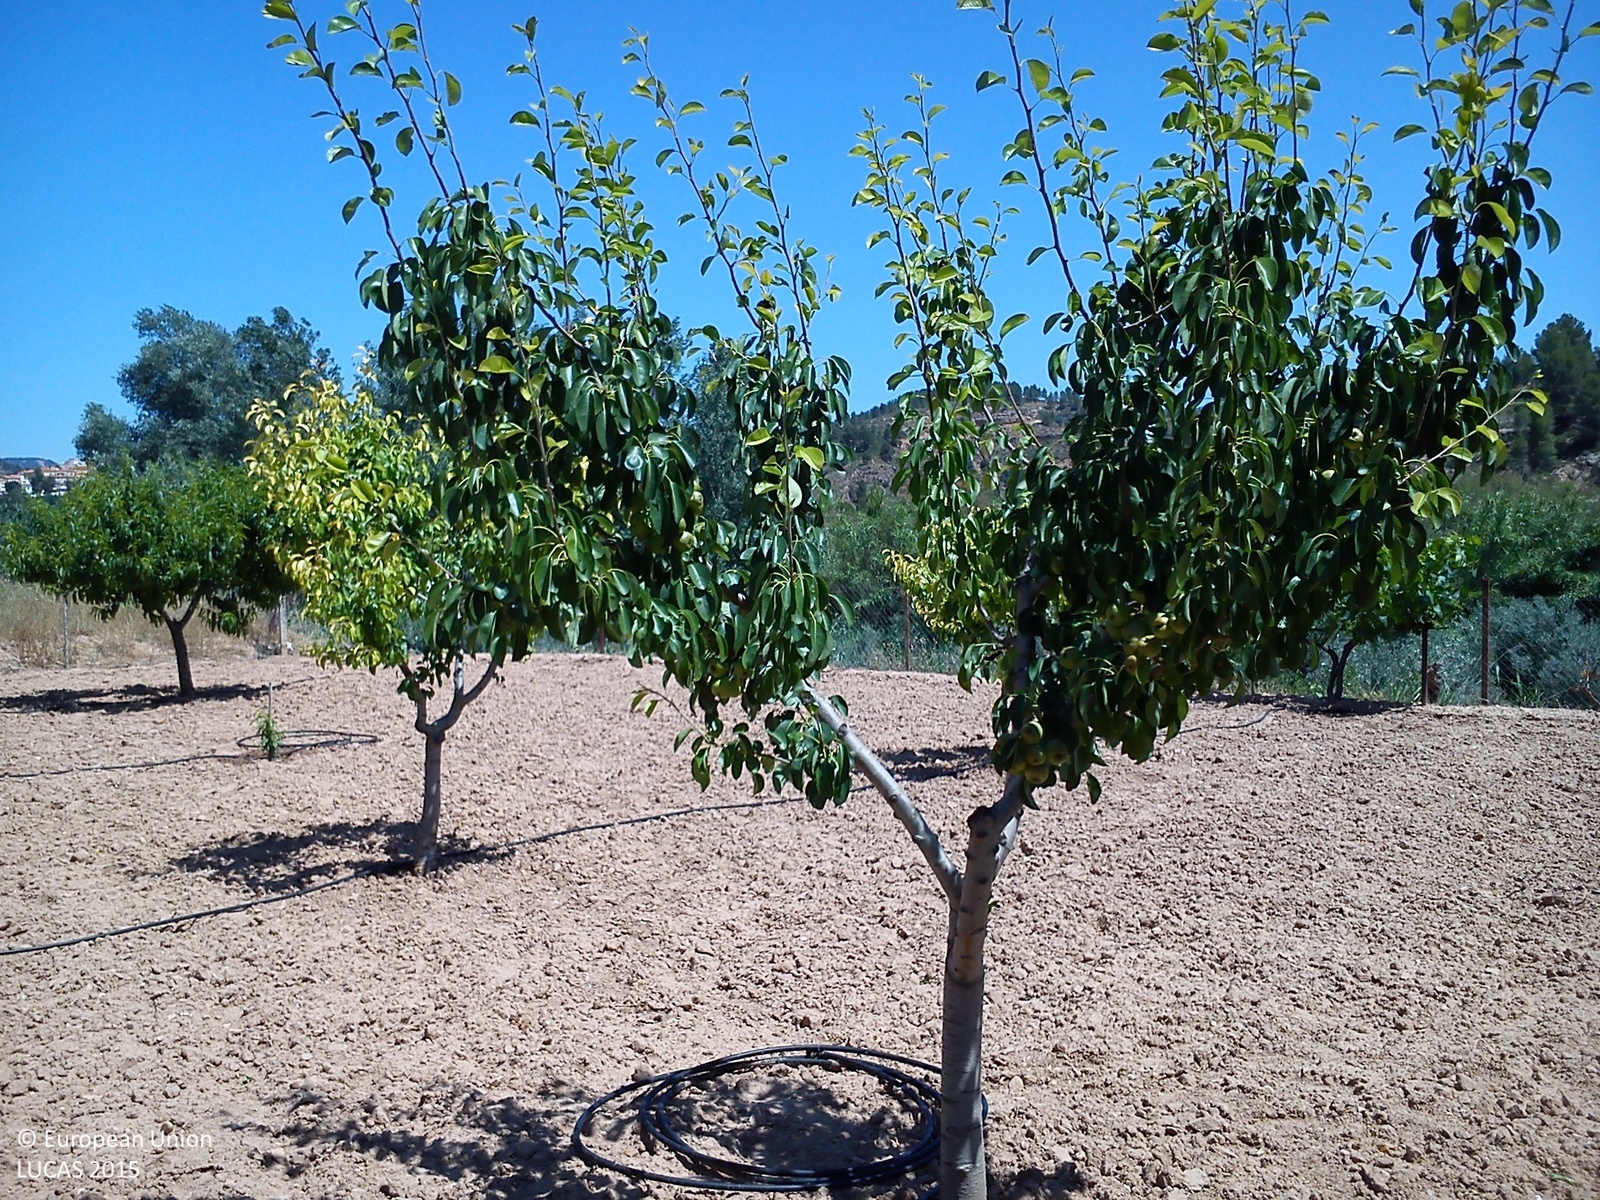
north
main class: Cropland
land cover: Cherry fruit
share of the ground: 10 - 25 %
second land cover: Other bare soil
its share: > 75 %
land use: Agriculture (excluding fallow land and kitchen gardens)
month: June
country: ES
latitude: 39.2203
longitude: -1.0595
